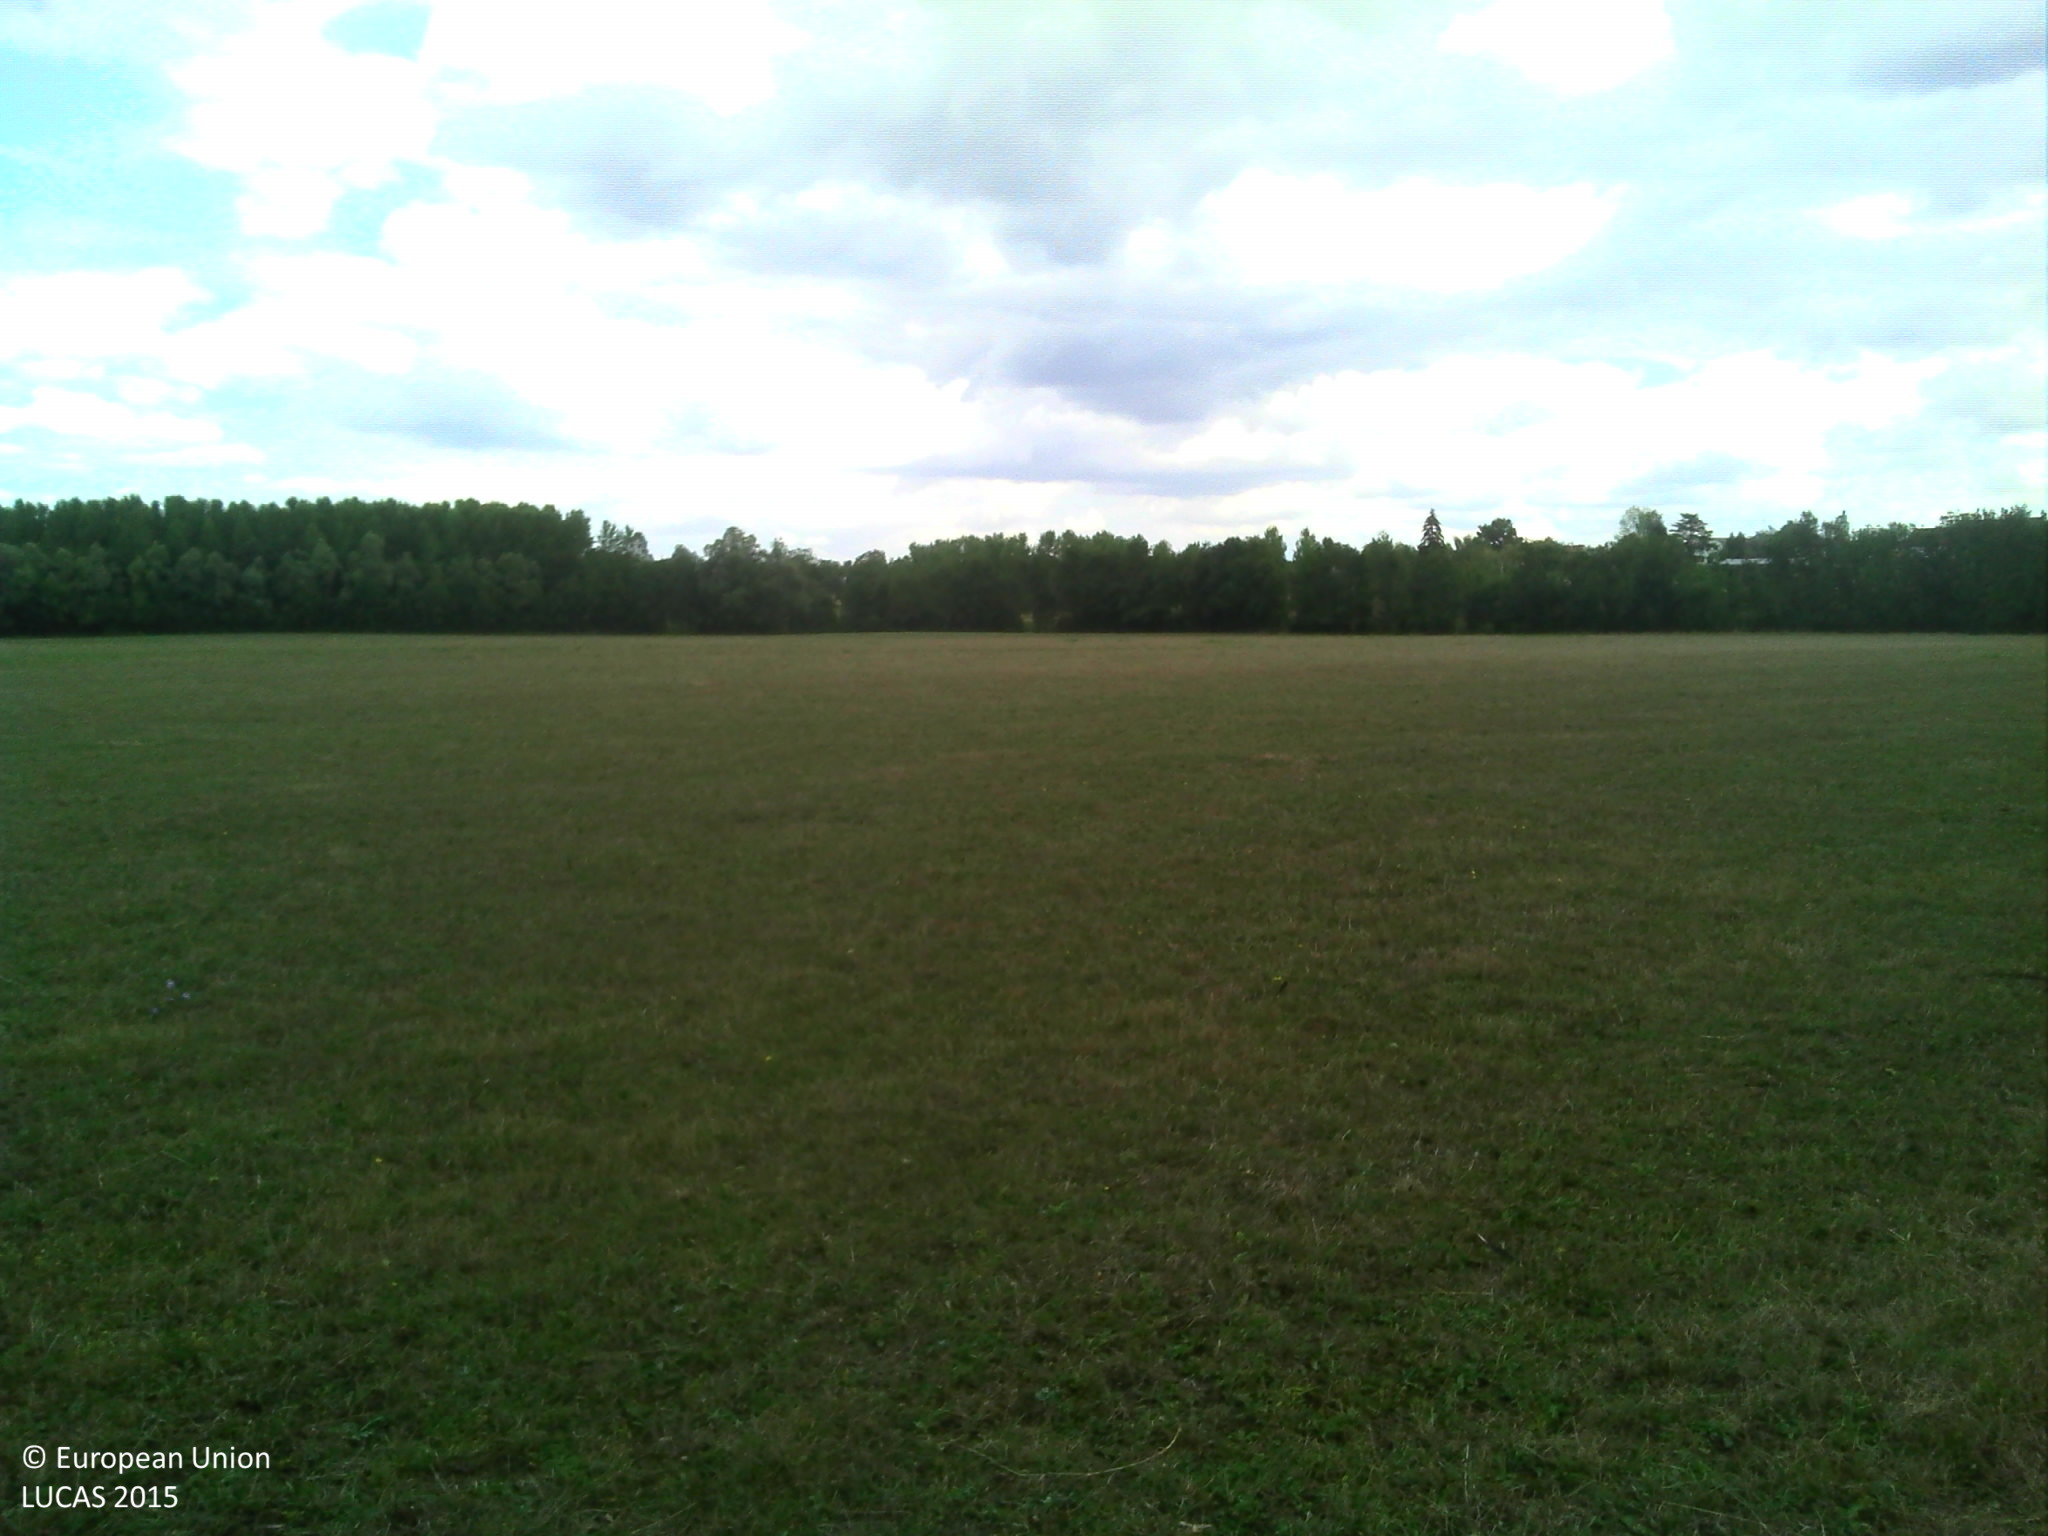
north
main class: Grassland
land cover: Grassland without tree/shrub cover
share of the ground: > 75 %
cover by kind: herbaceous plants 100 %
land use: Agriculture (excluding fallow land and kitchen gardens)
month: July
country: FR
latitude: 46.7353
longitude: 4.9107
